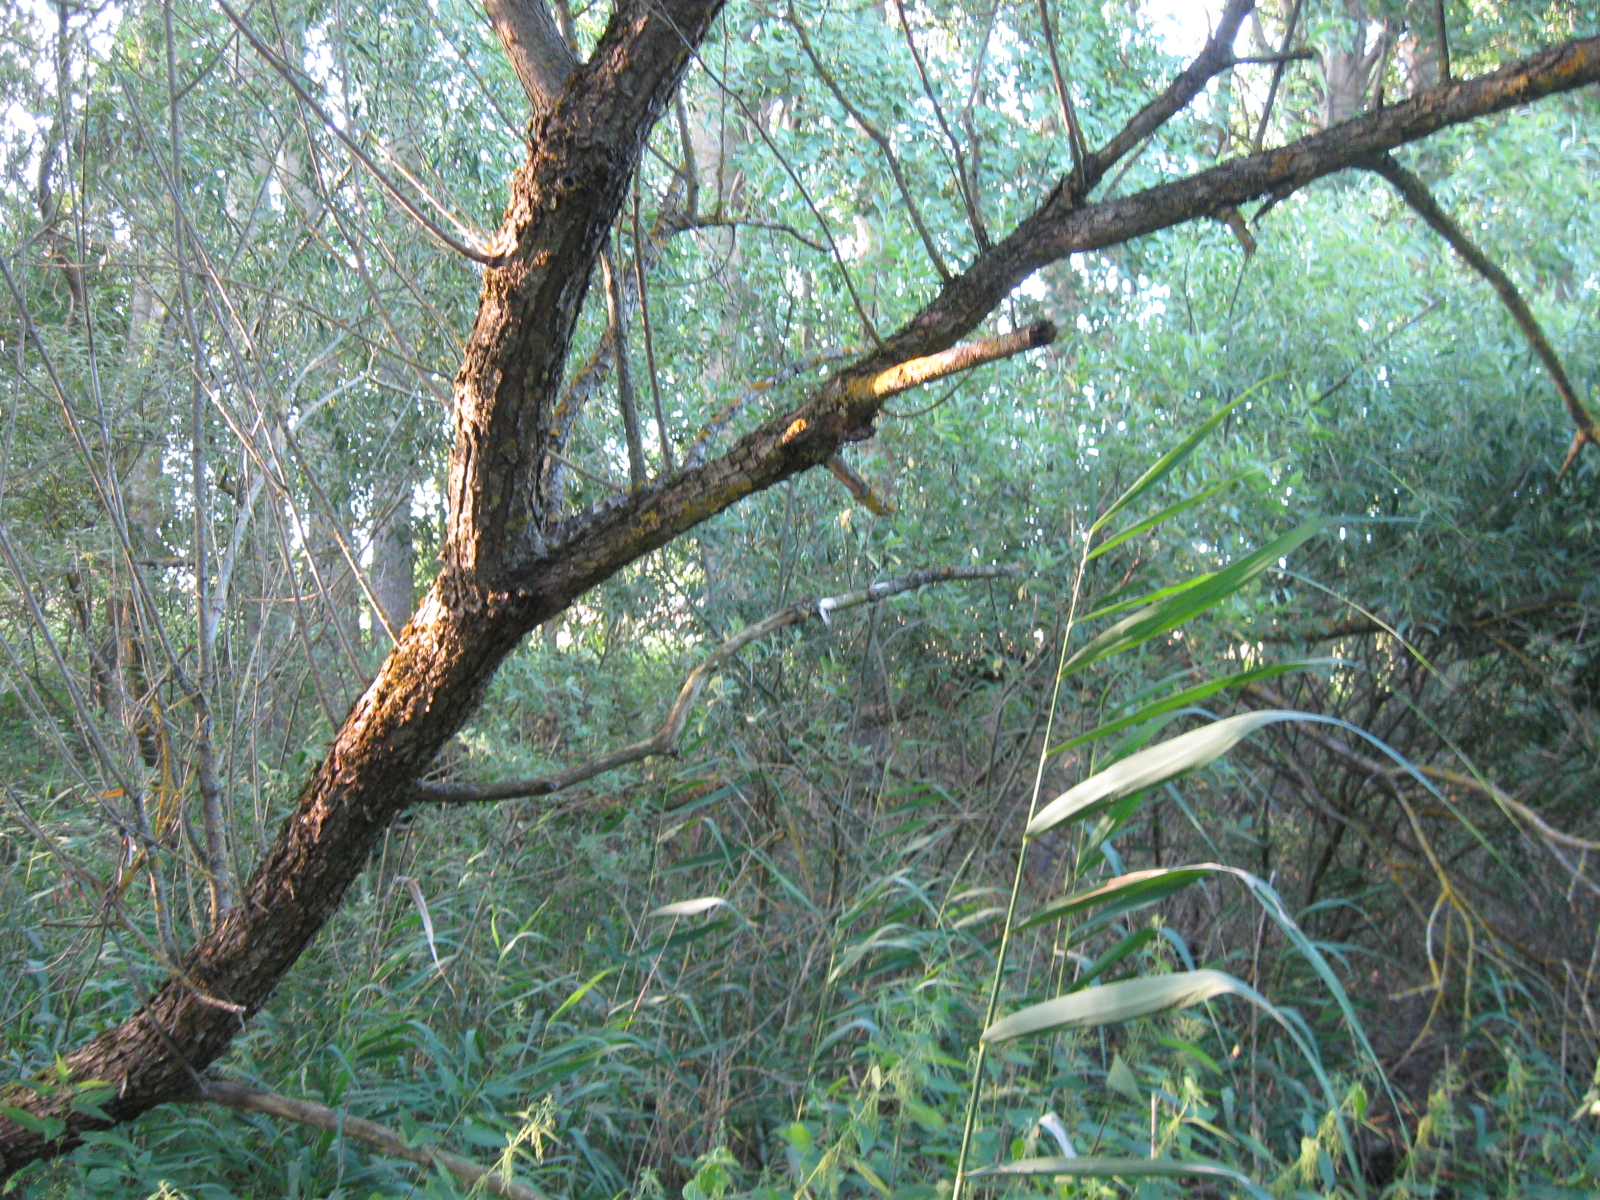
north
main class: Woodland
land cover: Broadleaved woodland
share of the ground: > 75 %
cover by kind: broadleaved forest trees 80 %, herbaceous plants 20 %
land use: Semi-natural and natural areas not in use
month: July
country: LT
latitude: 54.3338
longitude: 23.5397
